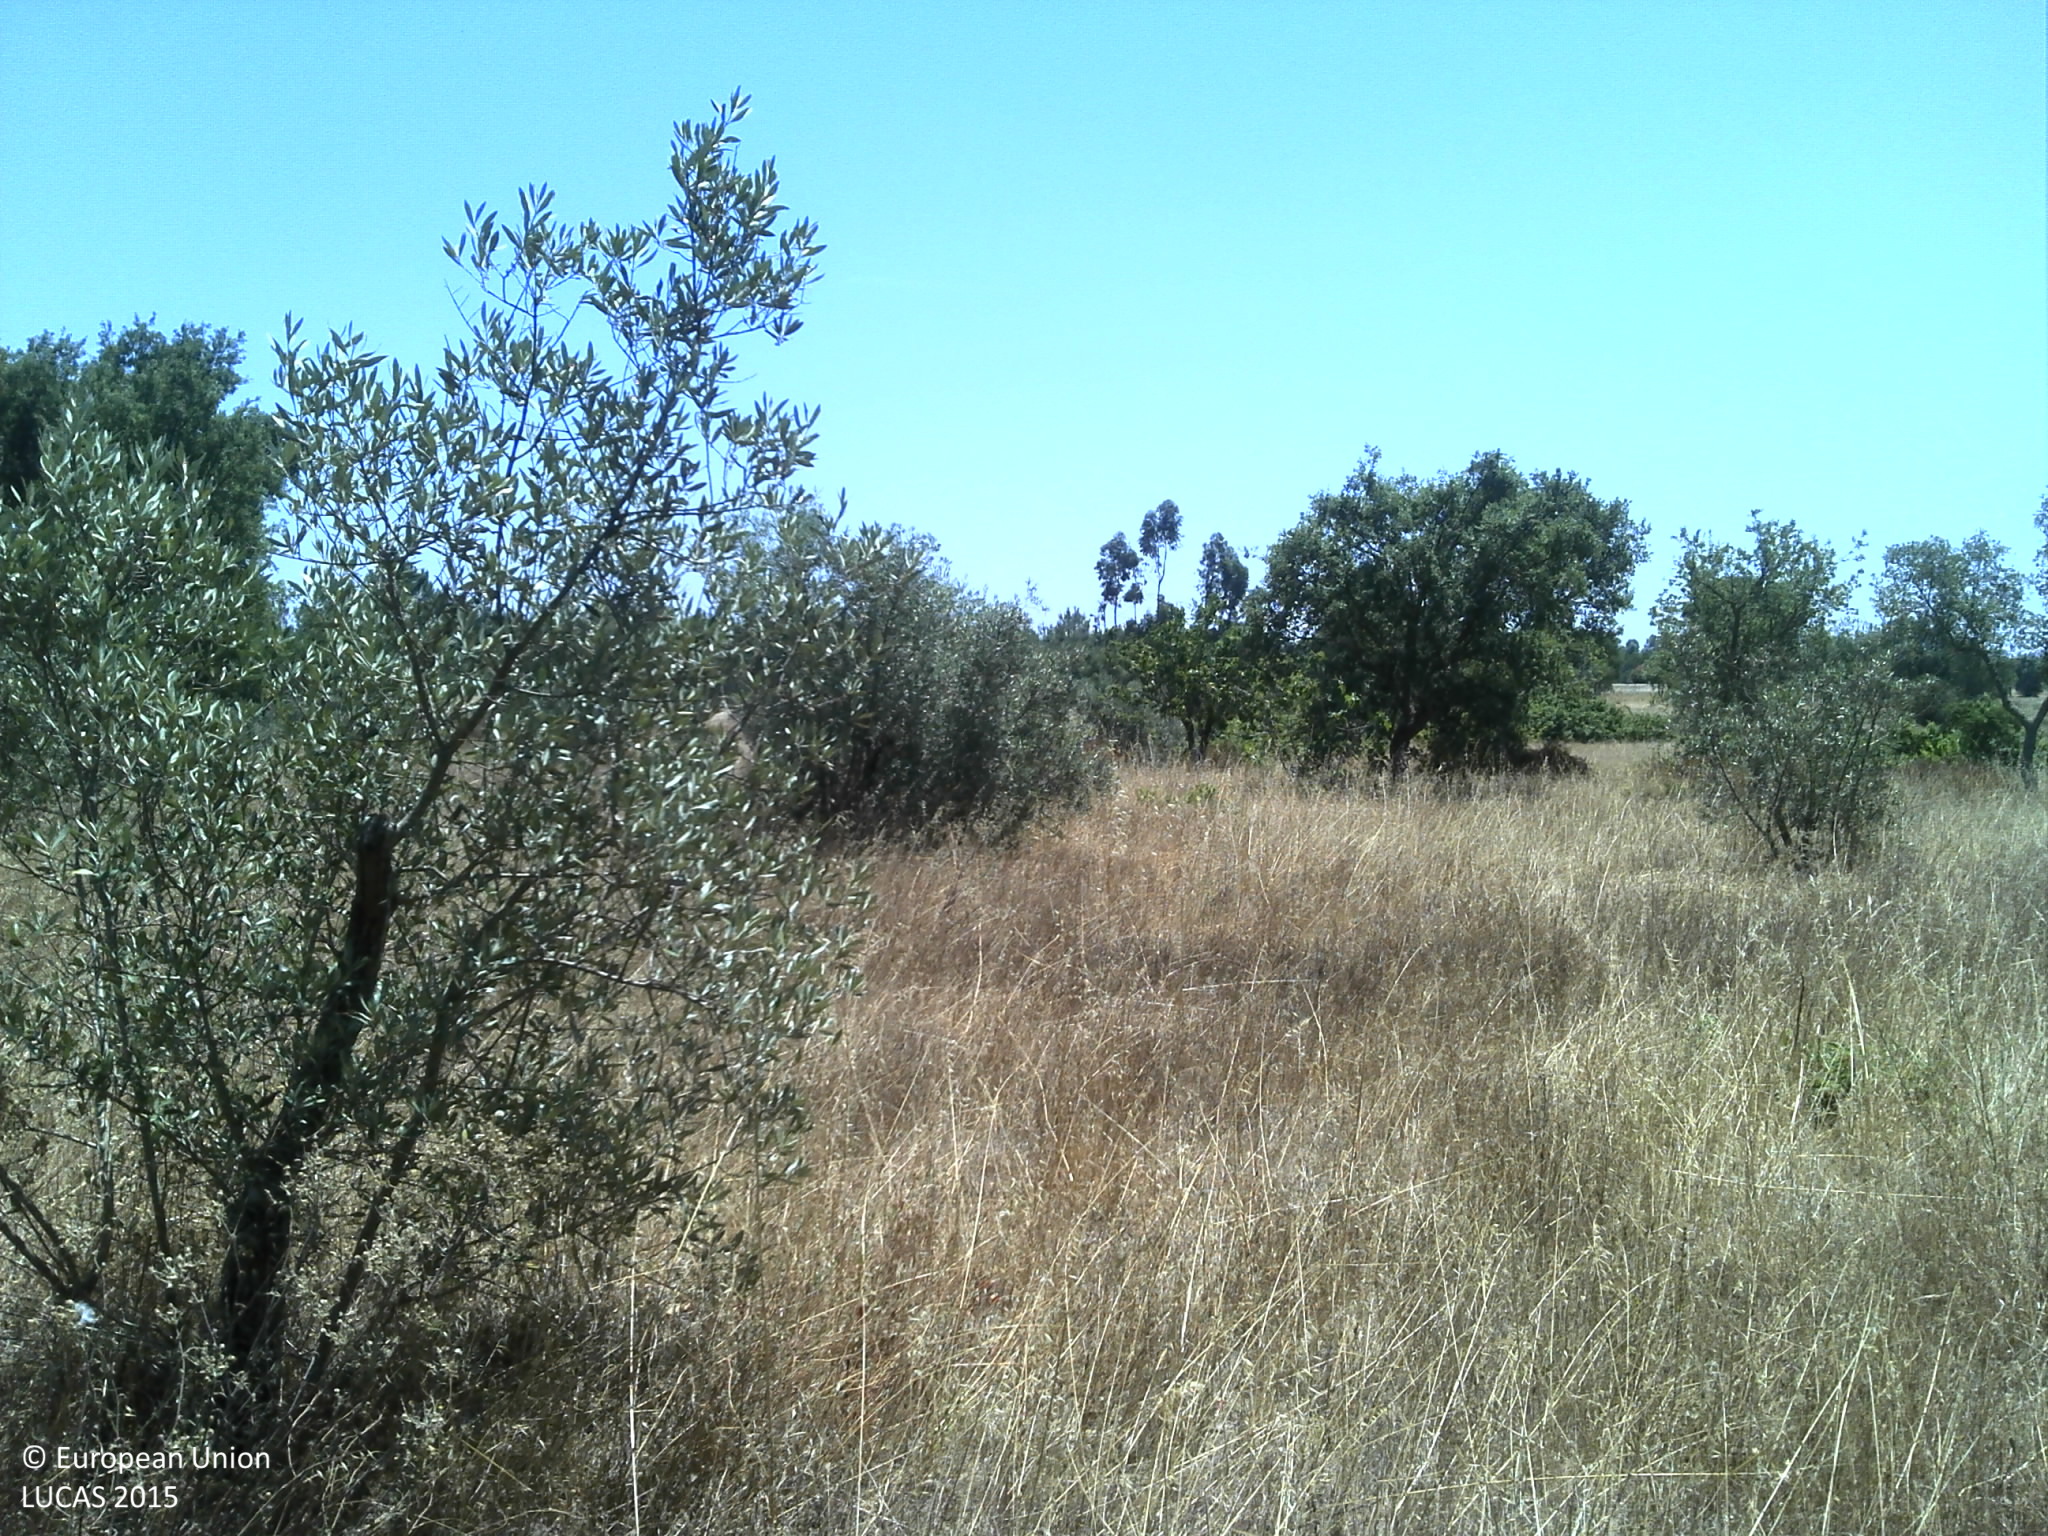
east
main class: Cropland
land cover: Olive groves
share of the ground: 25 - 50 %
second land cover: Grassland without tree/shrub cover
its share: 25 - 50 %
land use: Agriculture (excluding fallow land and kitchen gardens)
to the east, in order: Olive groves; Grassland without tree/shrub cover; Olive groves; Vineyards; Broadleaved woodland; Abandoned hedges; Pine dominated coniferous woodland; Grassland with sparse tree/shrub cover; Vineyards
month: June
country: PT
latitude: 39.0733
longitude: -8.6430
